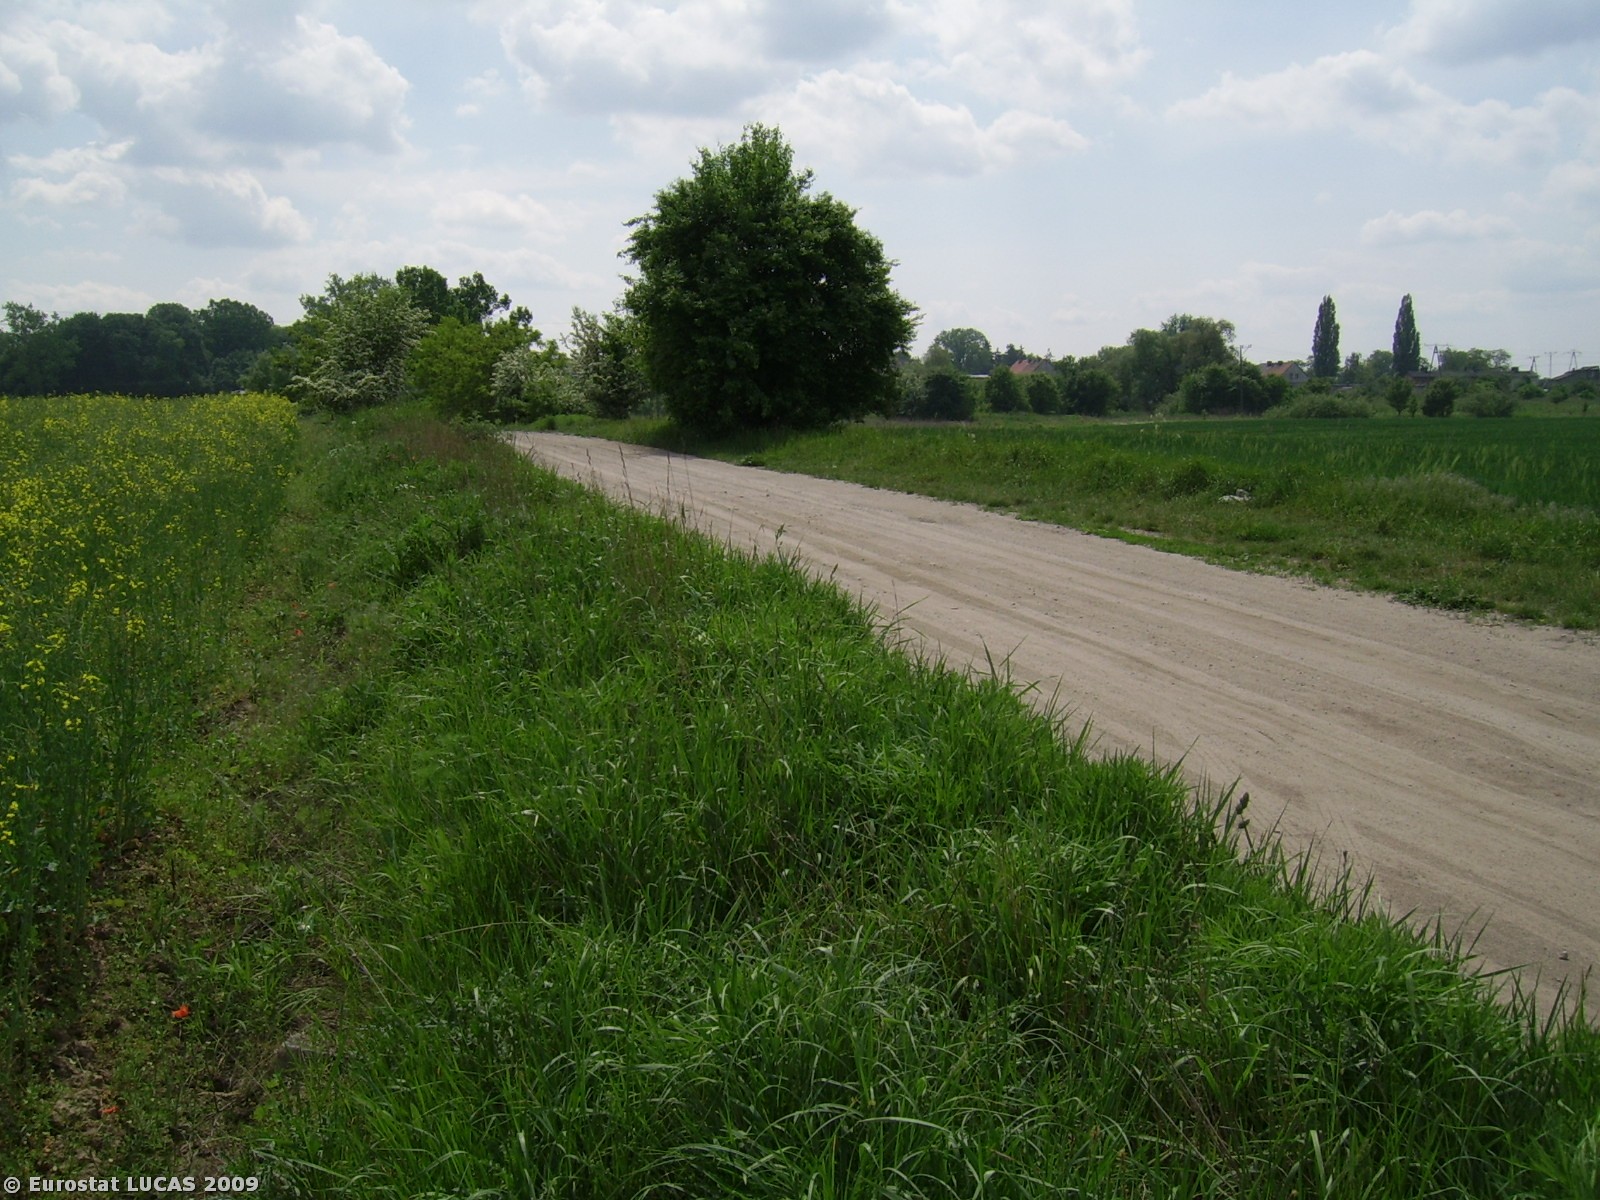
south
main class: Cropland
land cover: Rape and turnip rape
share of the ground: > 75 %
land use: Agriculture (excluding fallow land and kitchen gardens)
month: May
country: PL
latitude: 52.9201
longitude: 18.0022
